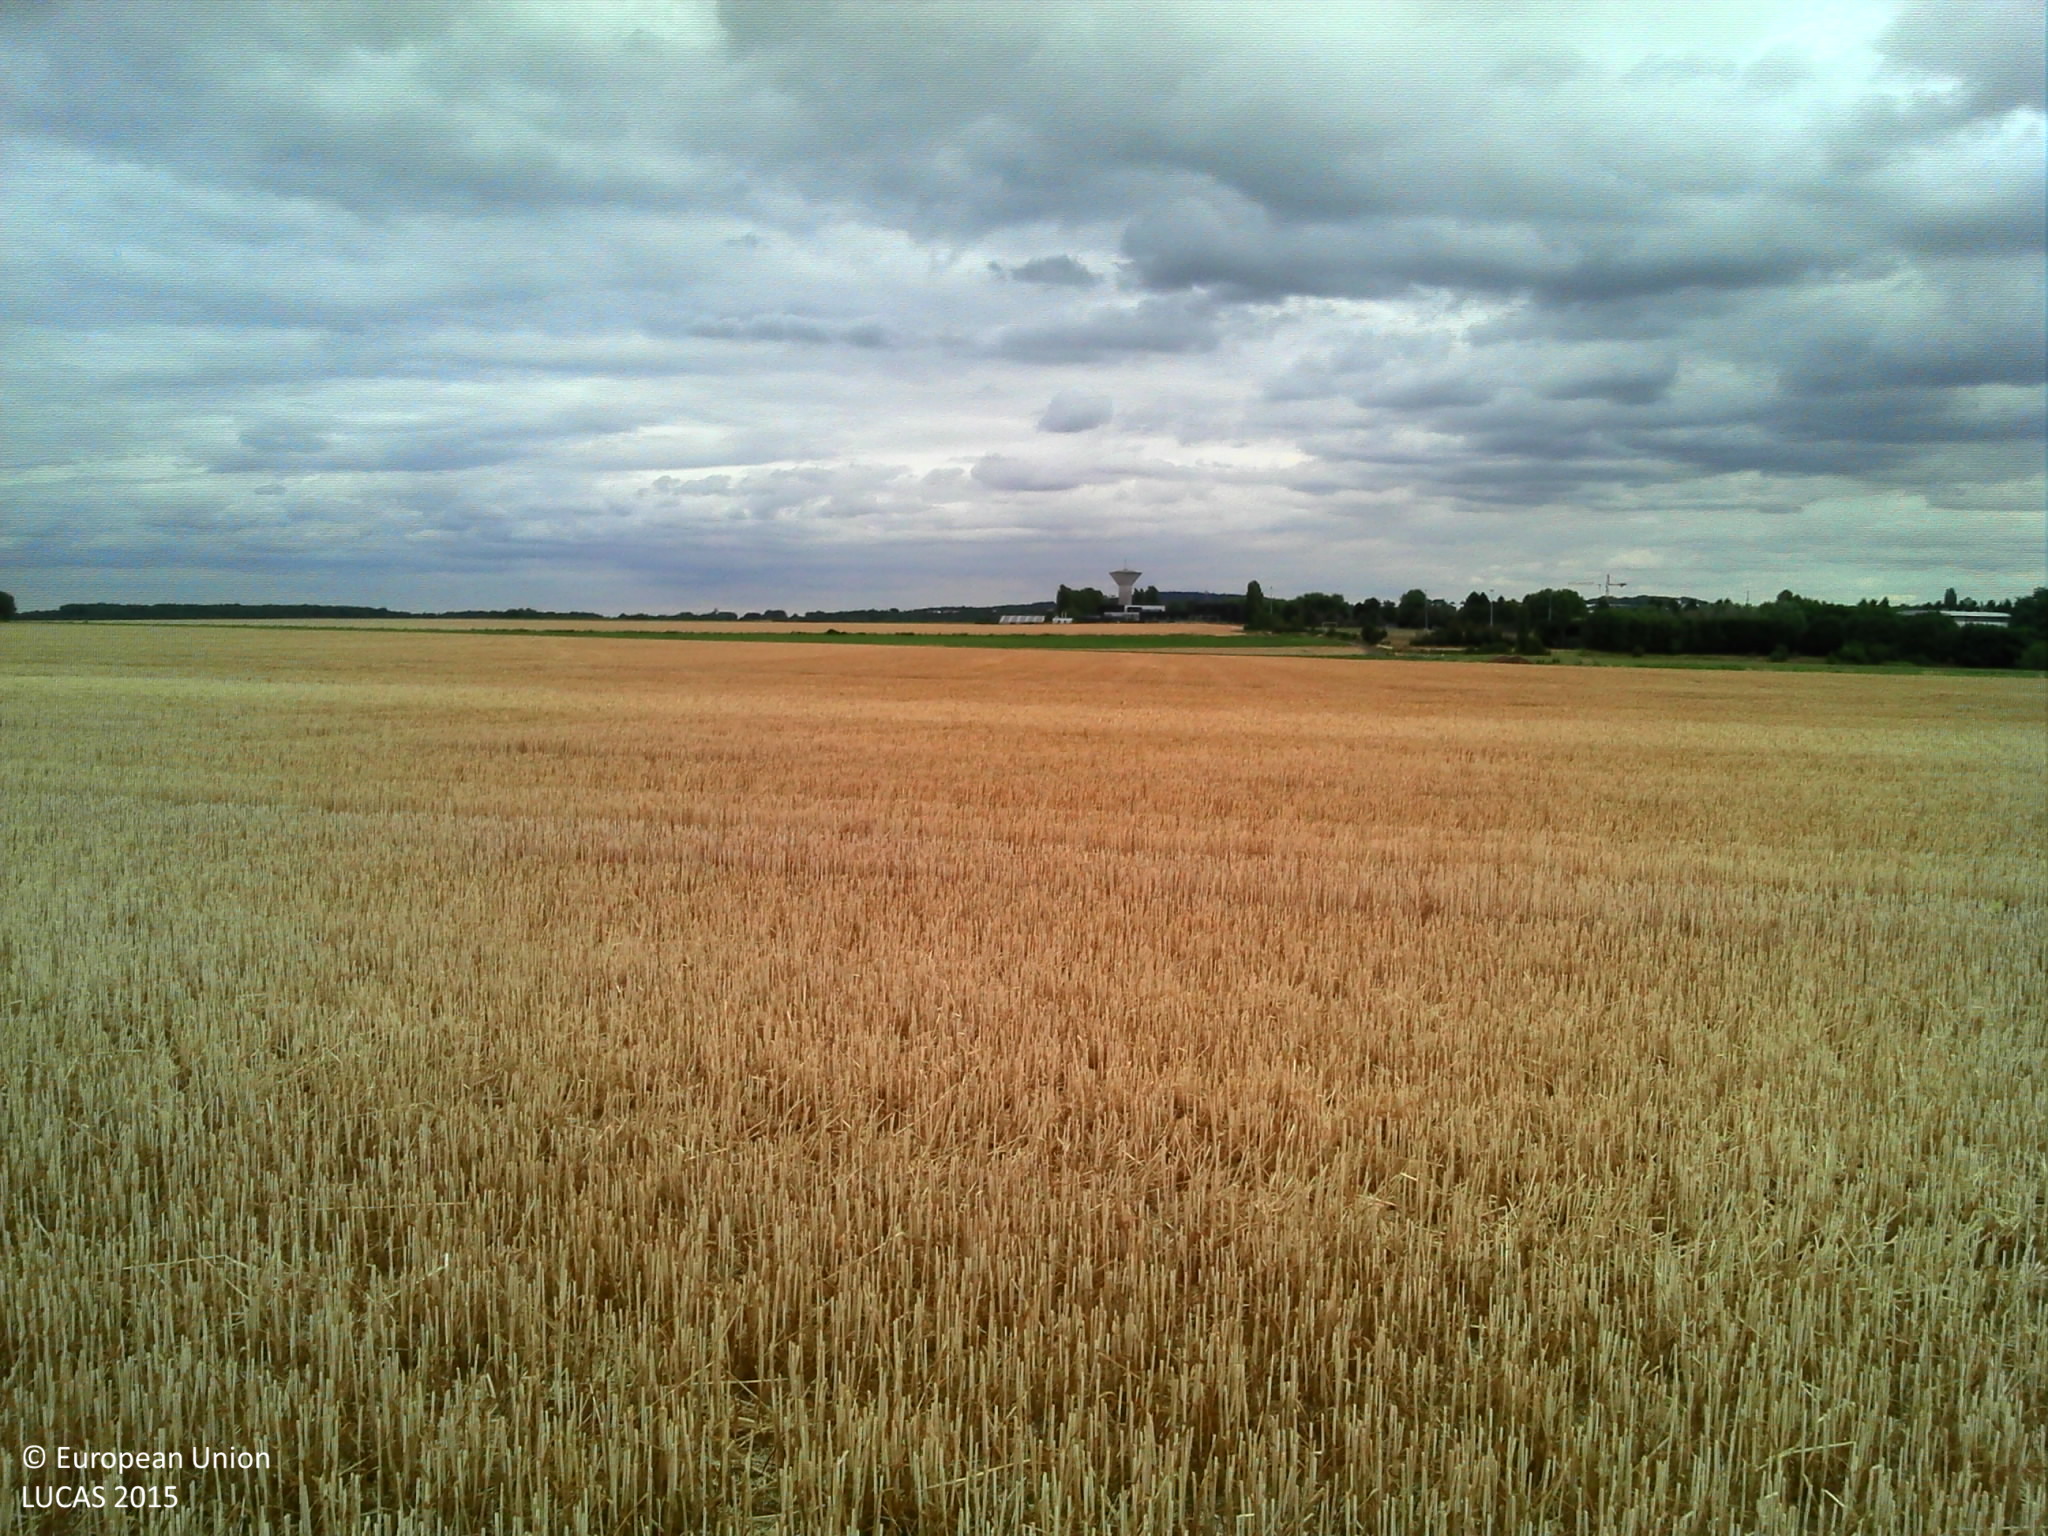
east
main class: Cropland
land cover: Common wheat
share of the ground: > 75 %
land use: Agriculture (excluding fallow land and kitchen gardens)
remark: Harvested field
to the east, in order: Common wheat
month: July
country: FR
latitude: 49.1059
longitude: 2.4956
